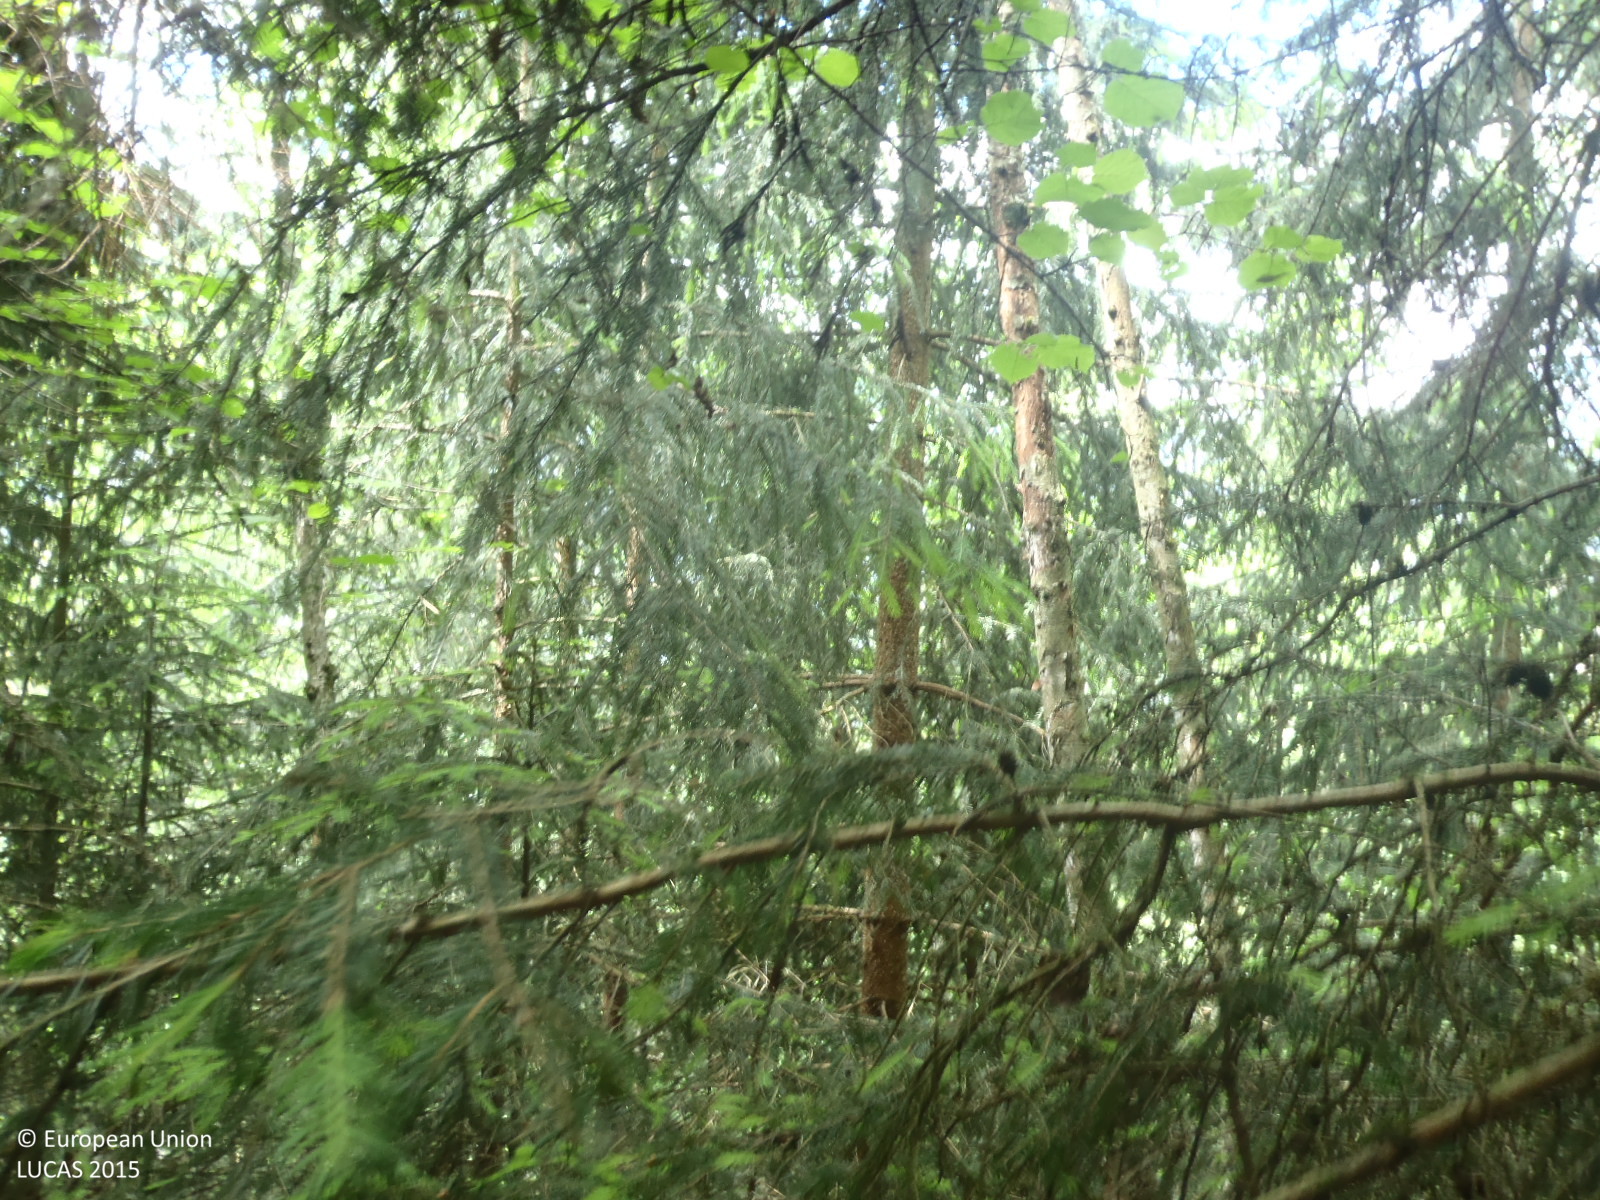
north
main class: Woodland
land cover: Spruce dominated mixed woodland
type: alpine coniferous forest
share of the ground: > 75 %
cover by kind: coniferous forest trees 75 %, broadleaved forest trees 25 %
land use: Abandoned areas
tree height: > 5 m
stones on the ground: < 10 %
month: June
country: AT
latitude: 47.2478
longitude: 10.9108
